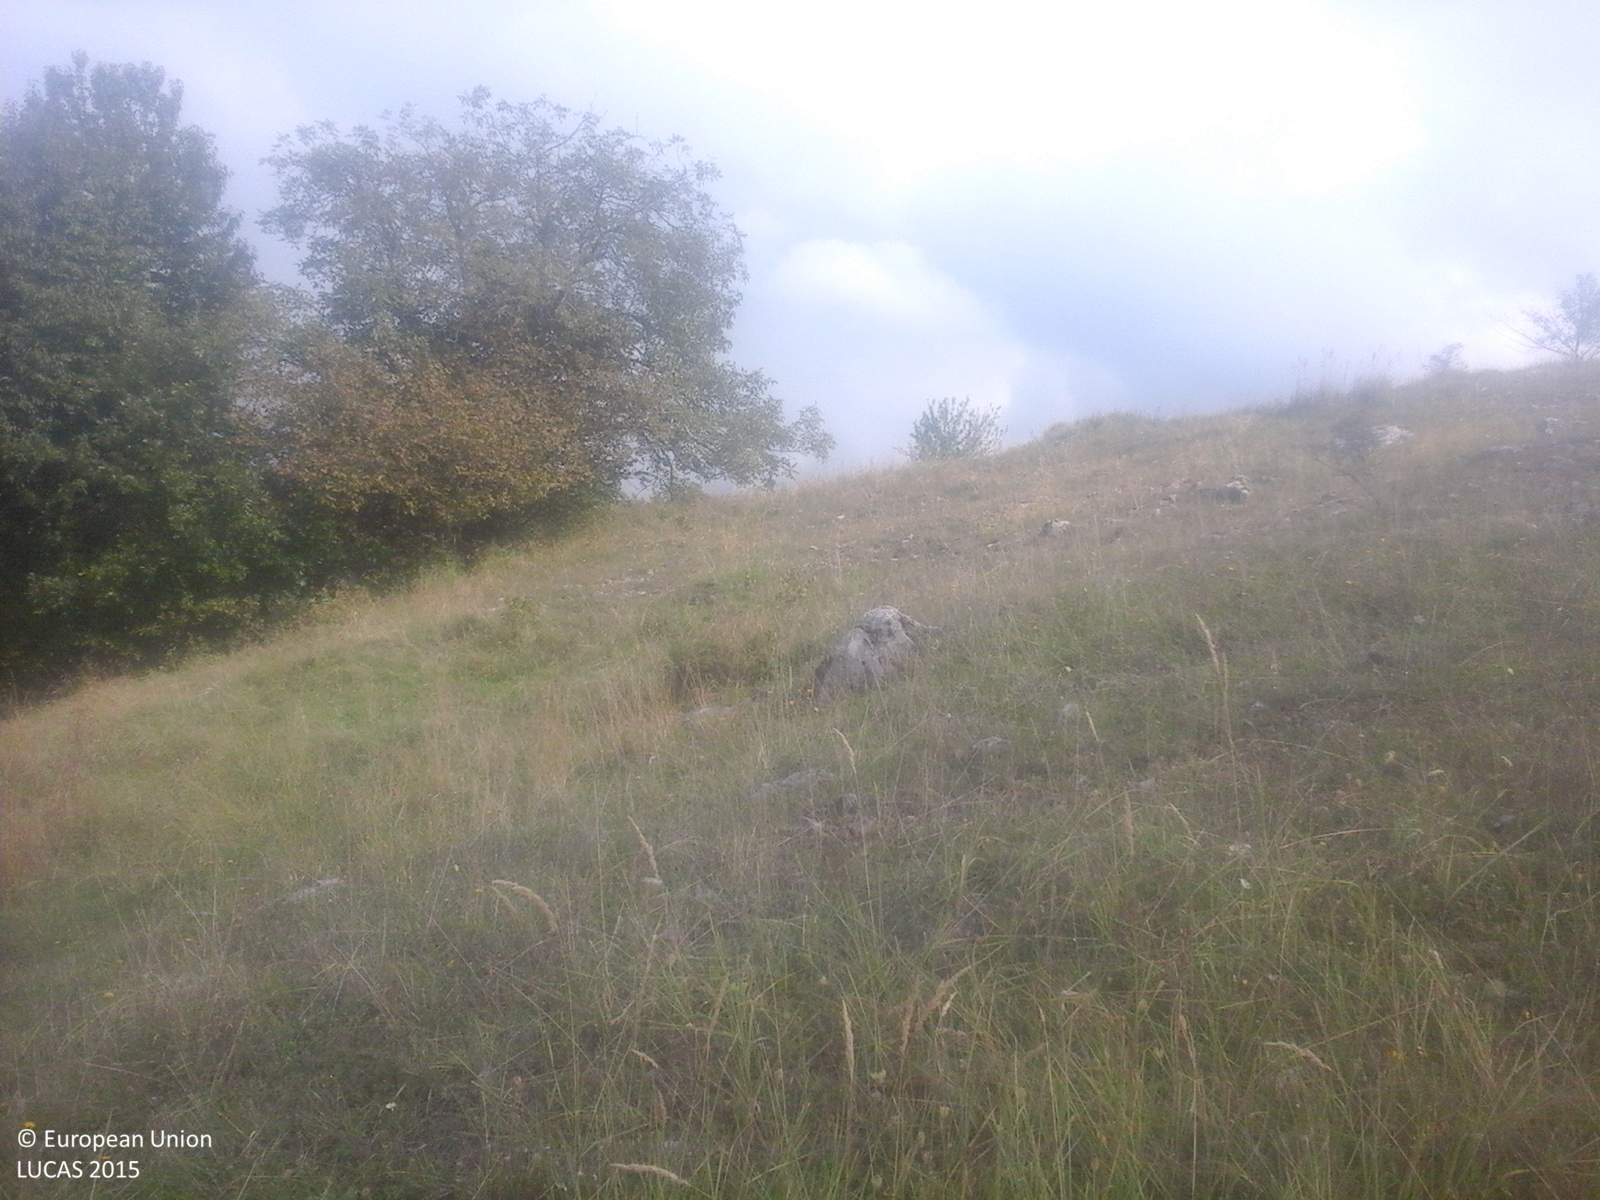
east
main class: Grassland
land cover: Grassland without tree/shrub cover
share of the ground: > 75 %
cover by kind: herbaceous plants 100 %
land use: Agriculture (excluding fallow land and kitchen gardens)
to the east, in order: Grassland without tree/shrub cover; Grassland with sparse tree/shrub cover; Grassland without tree/shrub cover; Tracks; Grassland without tree/shrub cover; Single bushes/trees; Grassland without tree/shrub cover; Shrubland with sparse tree cover; Grassland without tree/shrub cover
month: September
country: RO
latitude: 46.8476
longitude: 22.3921
